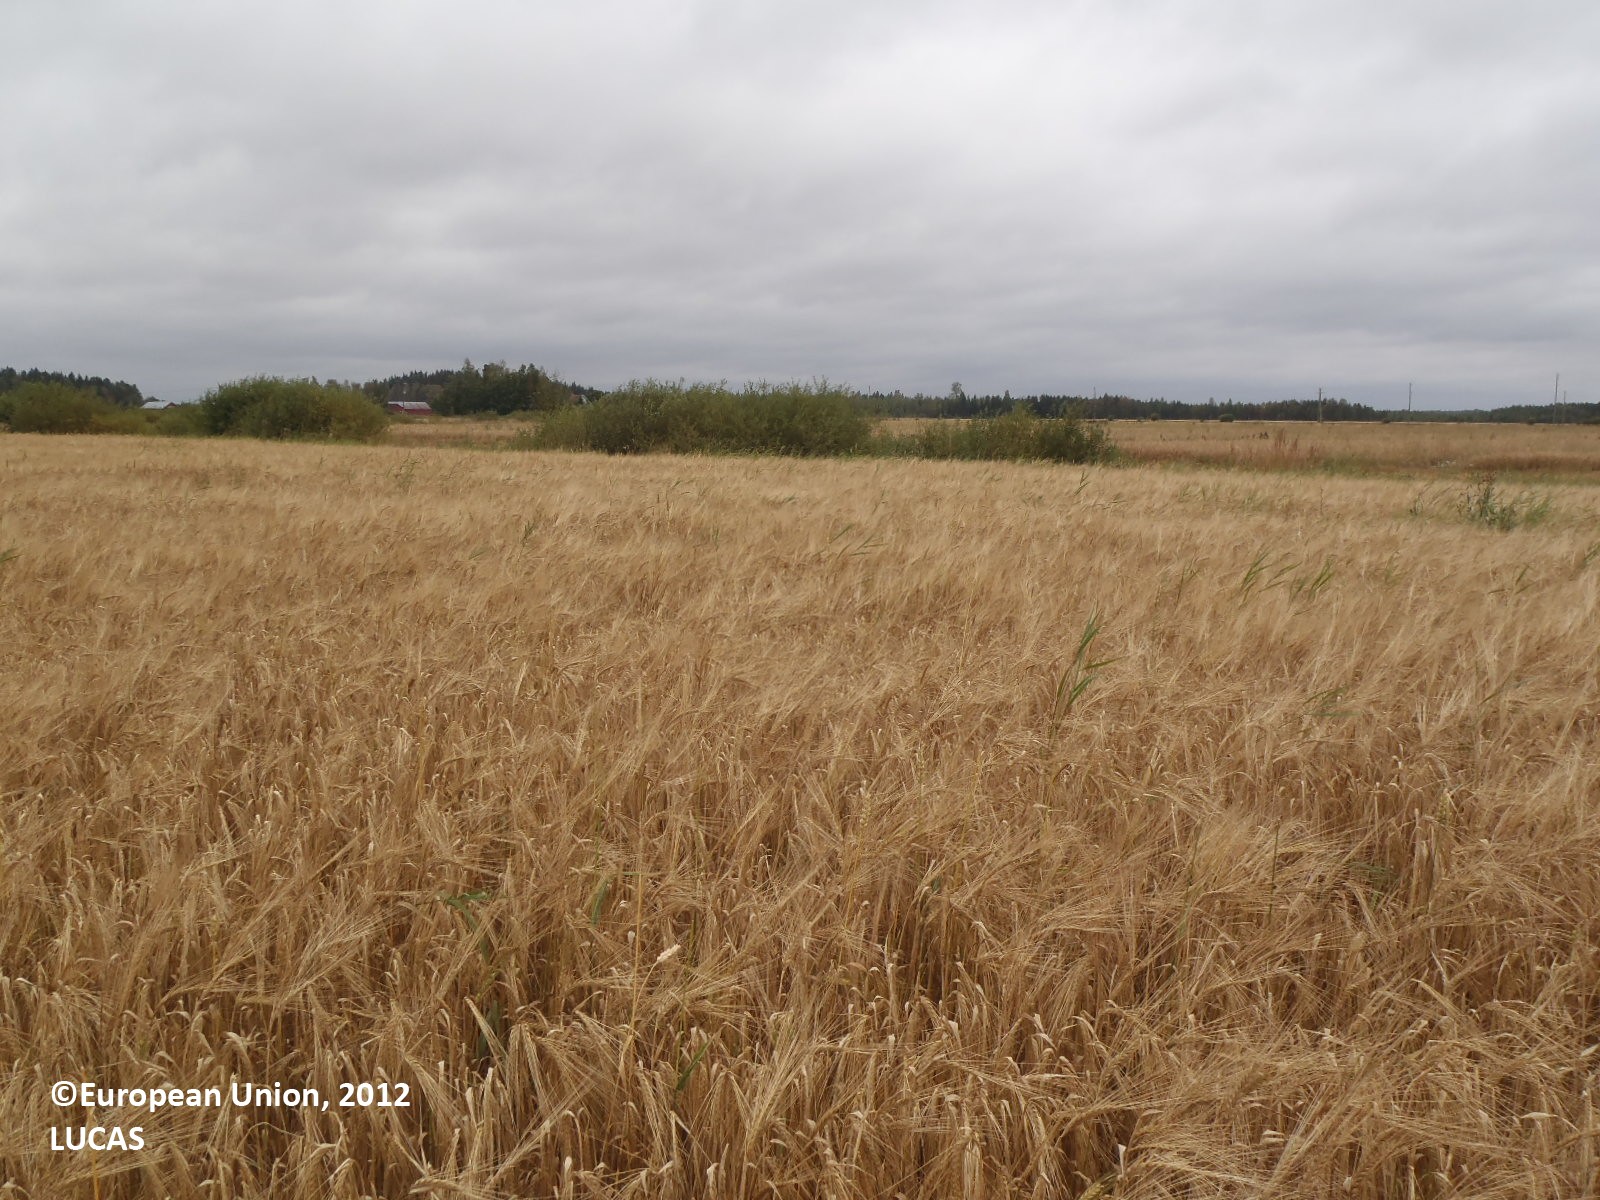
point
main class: Cropland
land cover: Barley
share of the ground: > 75 %
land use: Agriculture (excluding fallow land and kitchen gardens)
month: September
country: FI
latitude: 60.8001
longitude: 22.8072
